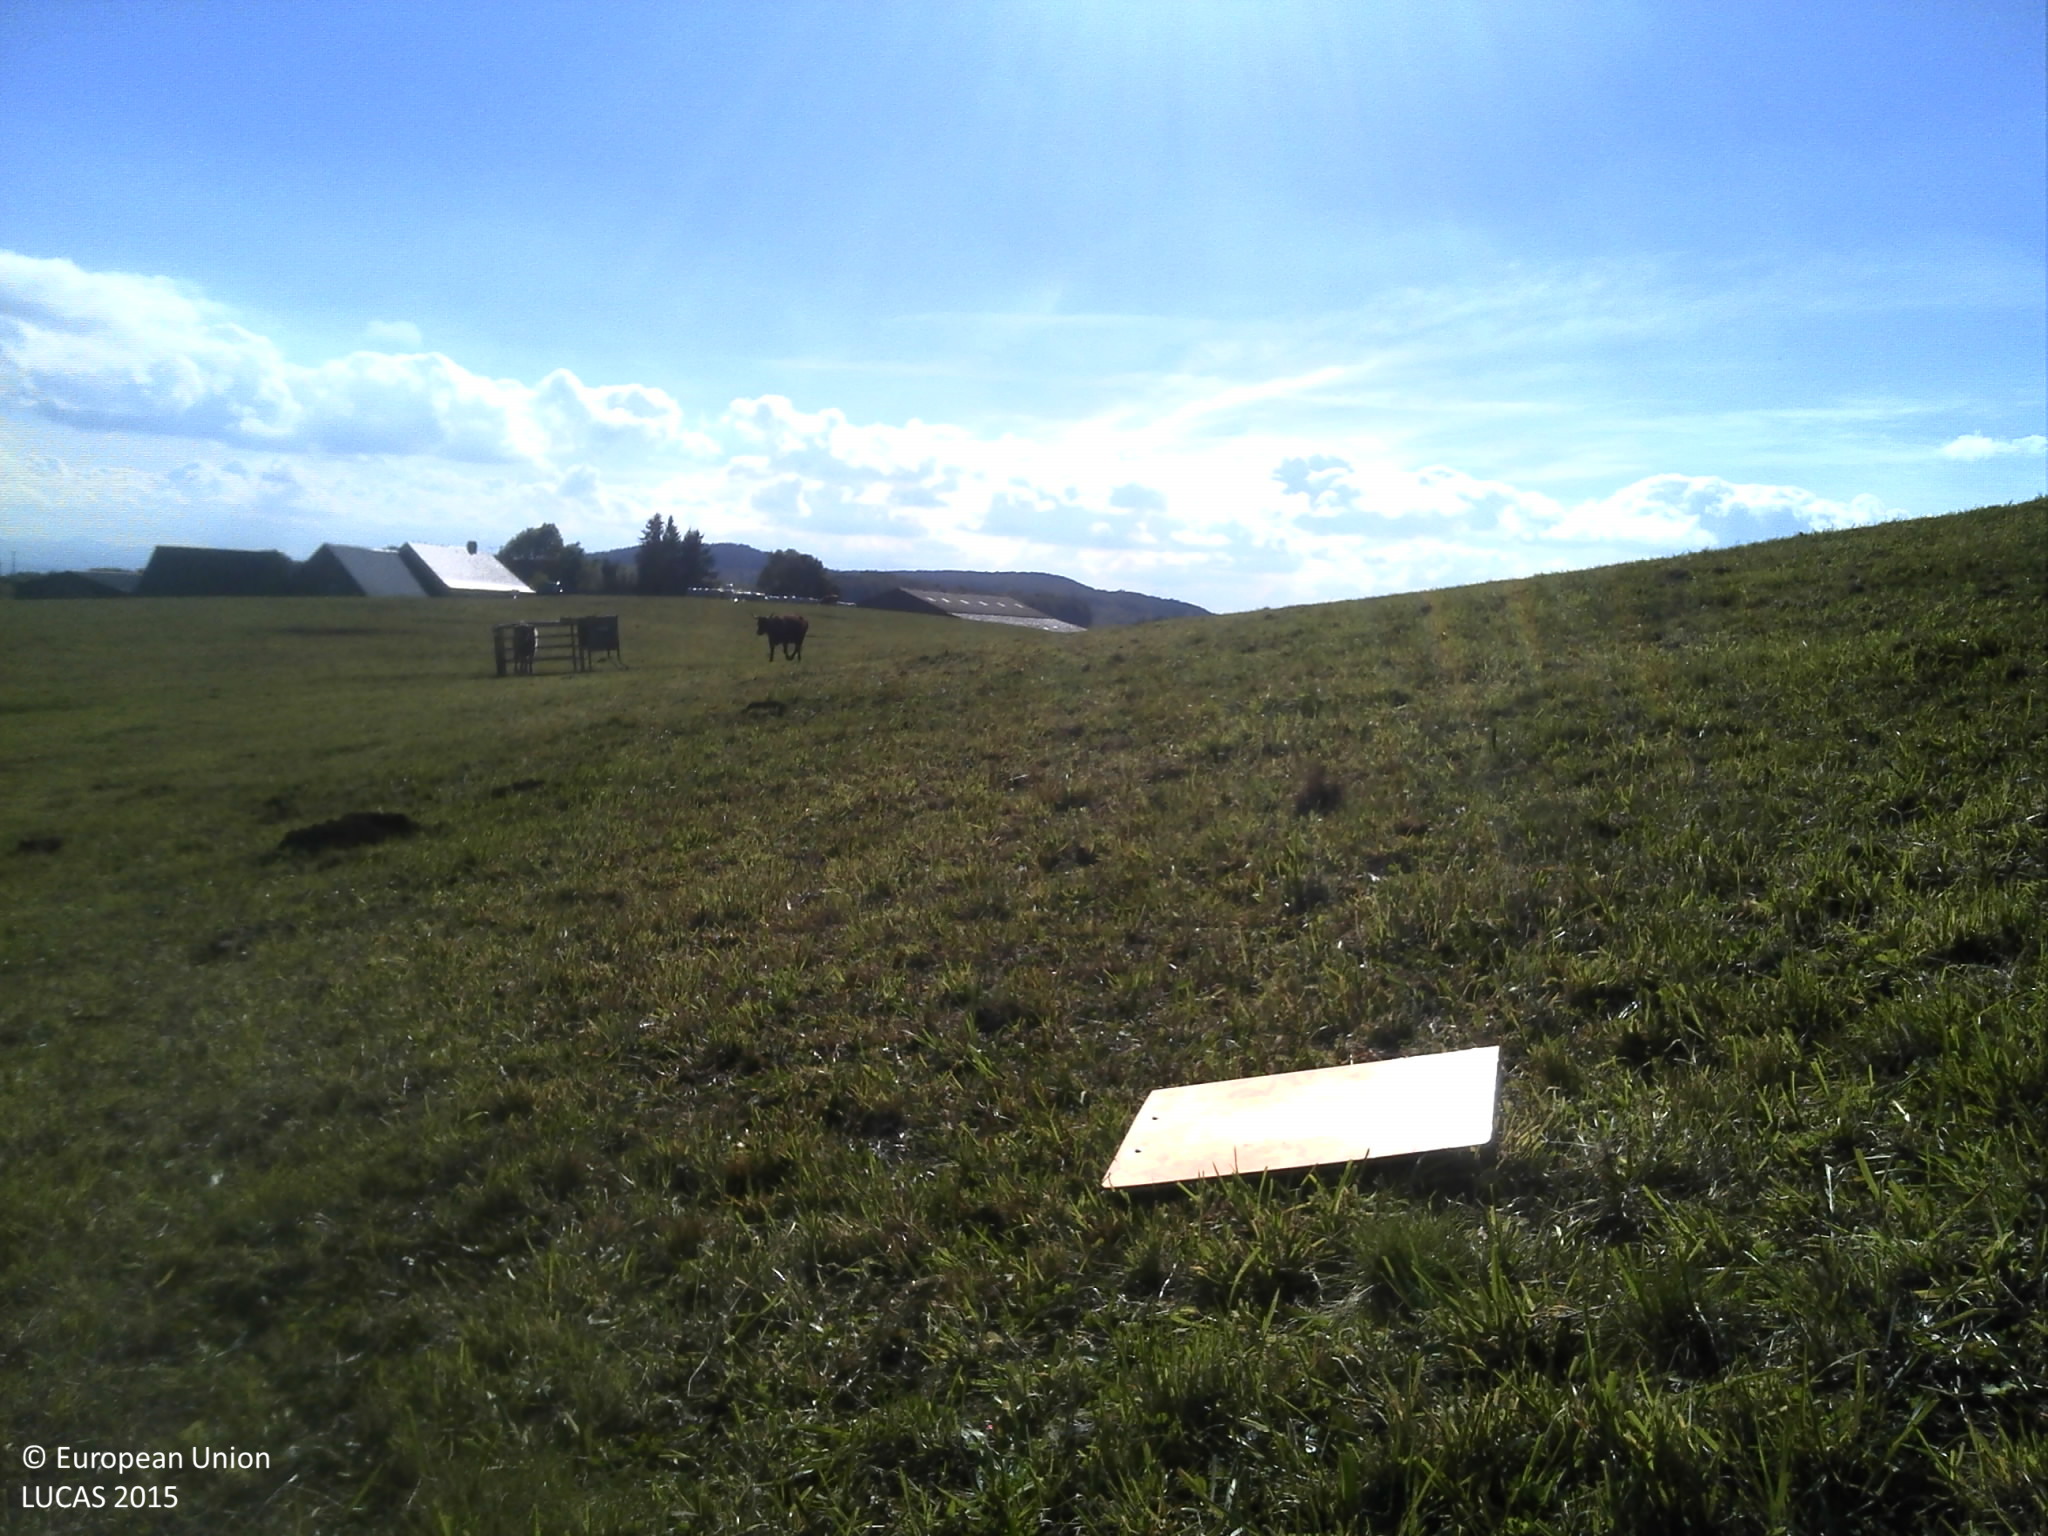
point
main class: Grassland
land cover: Grassland without tree/shrub cover
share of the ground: > 75 %
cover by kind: herbaceous plants 100 %
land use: Agriculture (excluding fallow land and kitchen gardens)
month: September
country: FR
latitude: 45.4788
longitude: 2.8487
